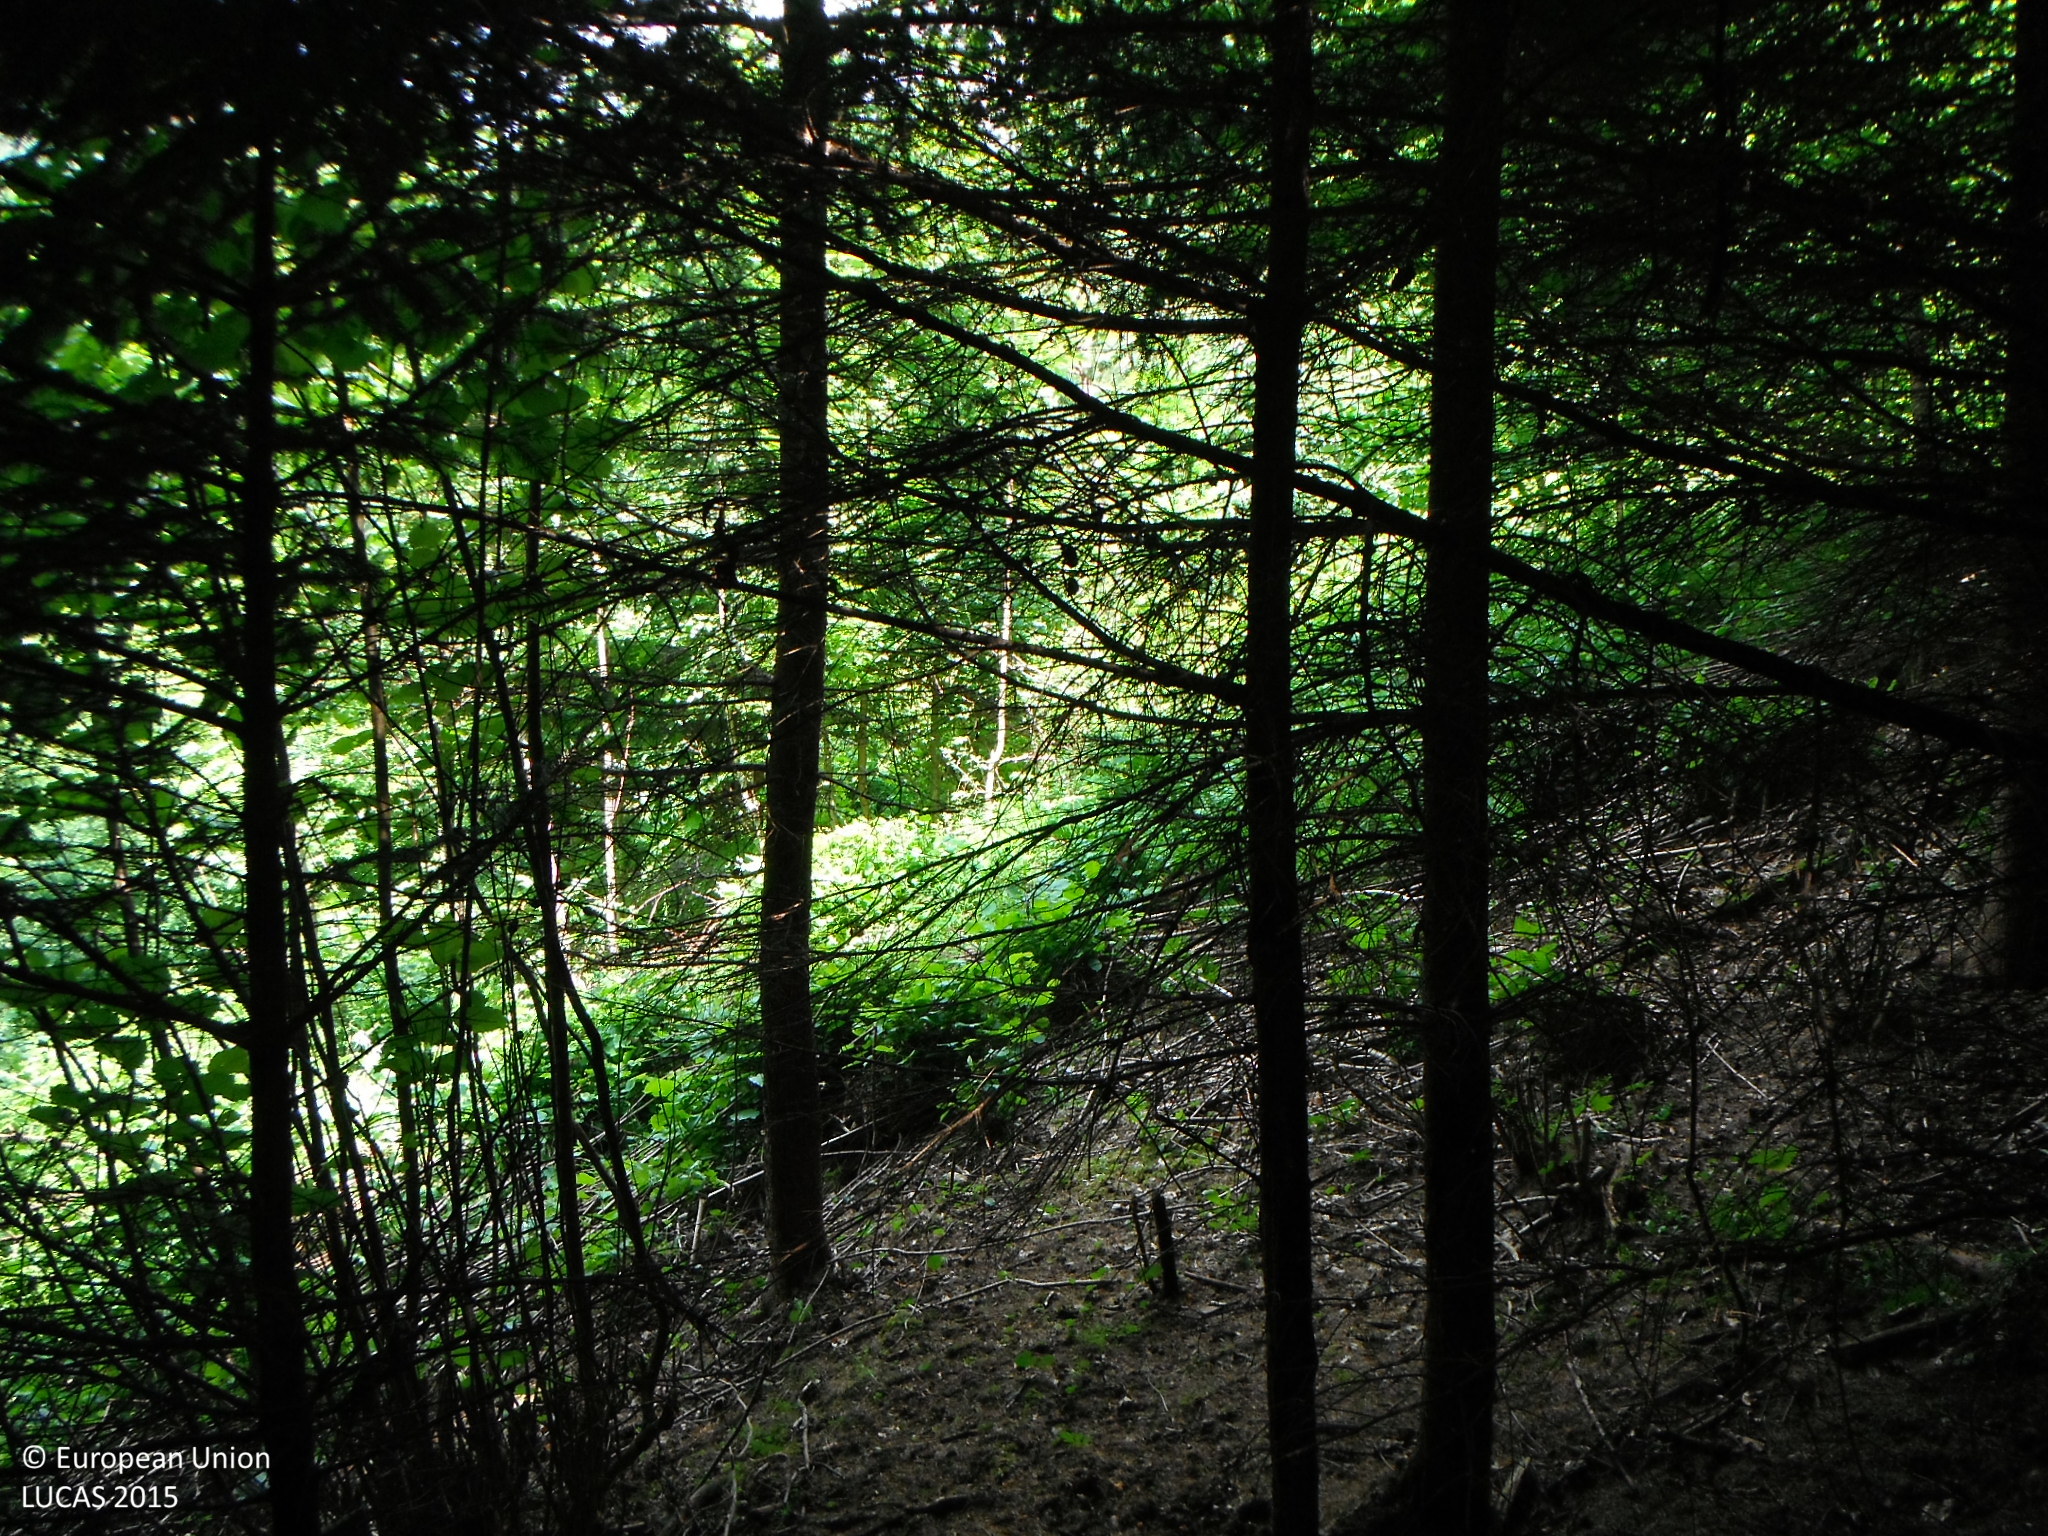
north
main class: Woodland
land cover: Spruce dominated coniferous woodland
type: alpine coniferous forest
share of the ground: > 75 %
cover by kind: coniferous forest trees 100 %
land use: Forestry
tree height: > 5 m
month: June
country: SK
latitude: 49.1222
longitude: 19.2180
